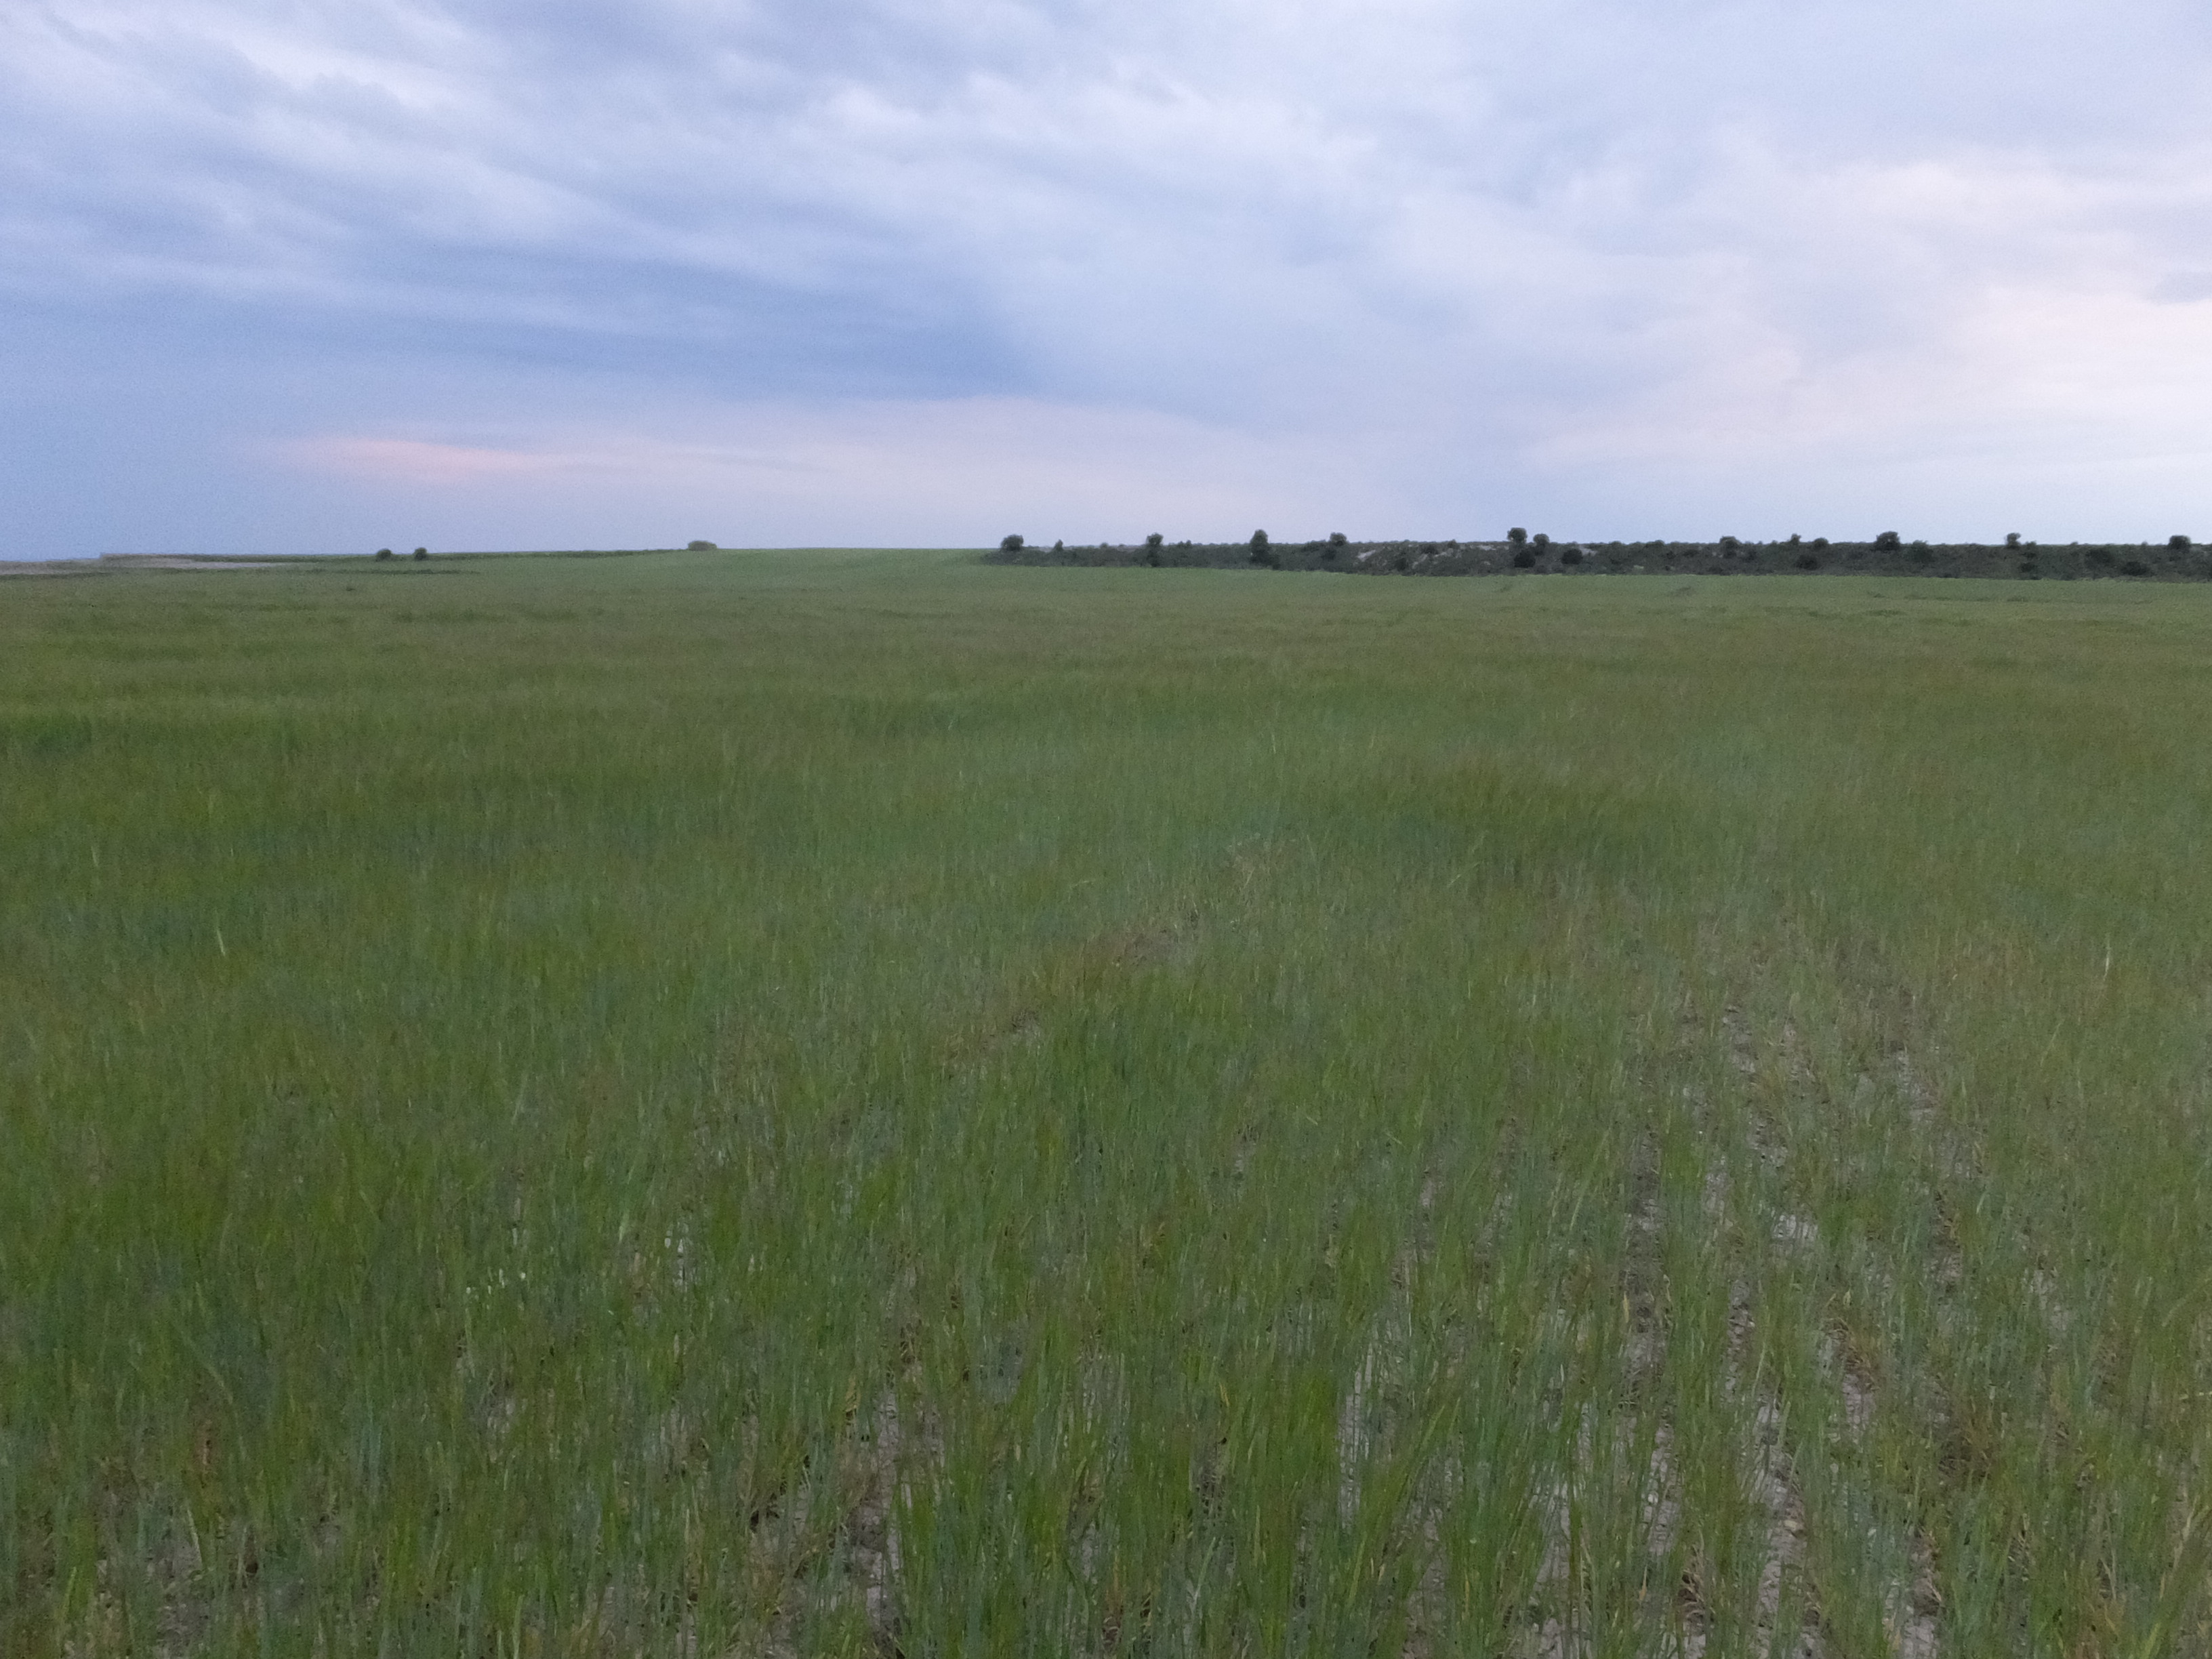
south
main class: Cropland
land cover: Barley
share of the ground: > 75 %
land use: Agriculture (excluding fallow land and kitchen gardens)
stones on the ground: < 10 %
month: April
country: ES
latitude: 41.6324
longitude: -0.1600
